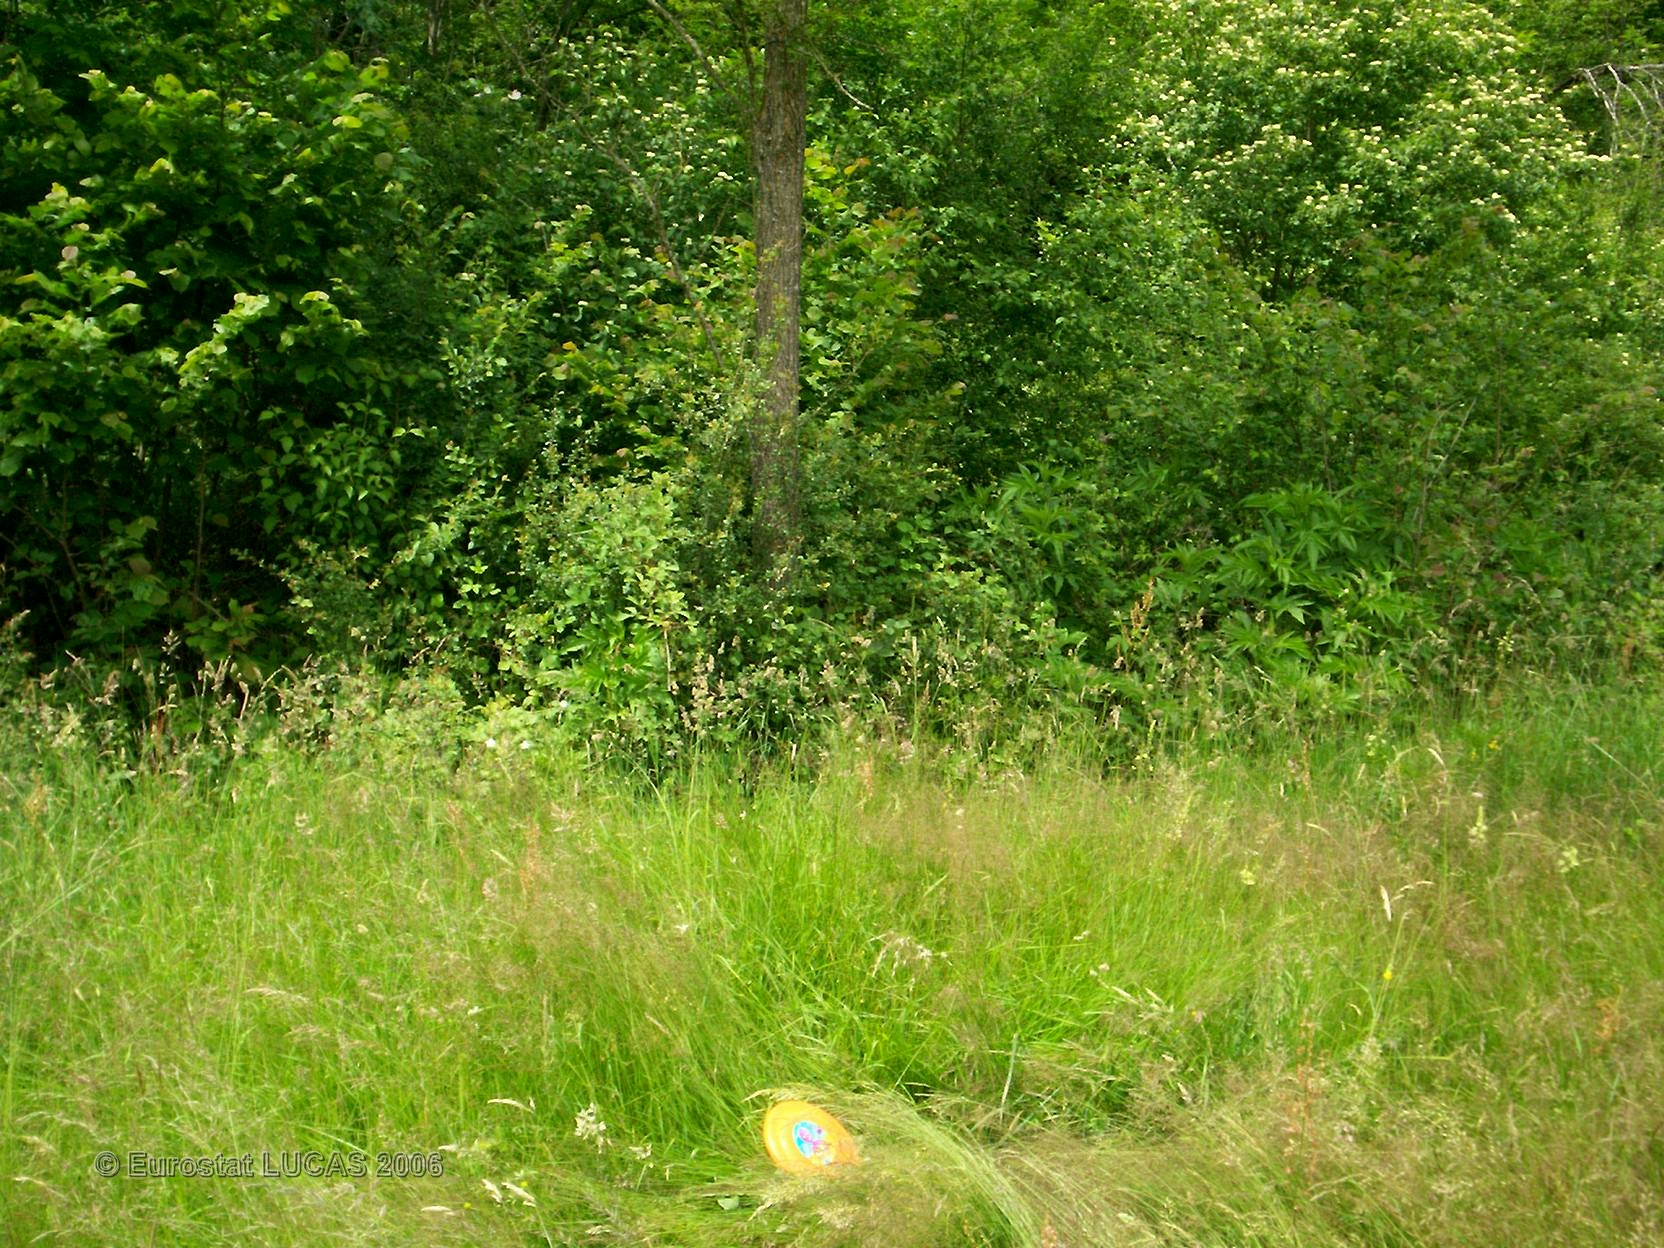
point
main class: Grassland
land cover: Grassland without tree/shrub cover
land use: Agriculture (excluding fallow land and kitchen gardens)
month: June
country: FR
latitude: 46.2331
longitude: 5.3738
